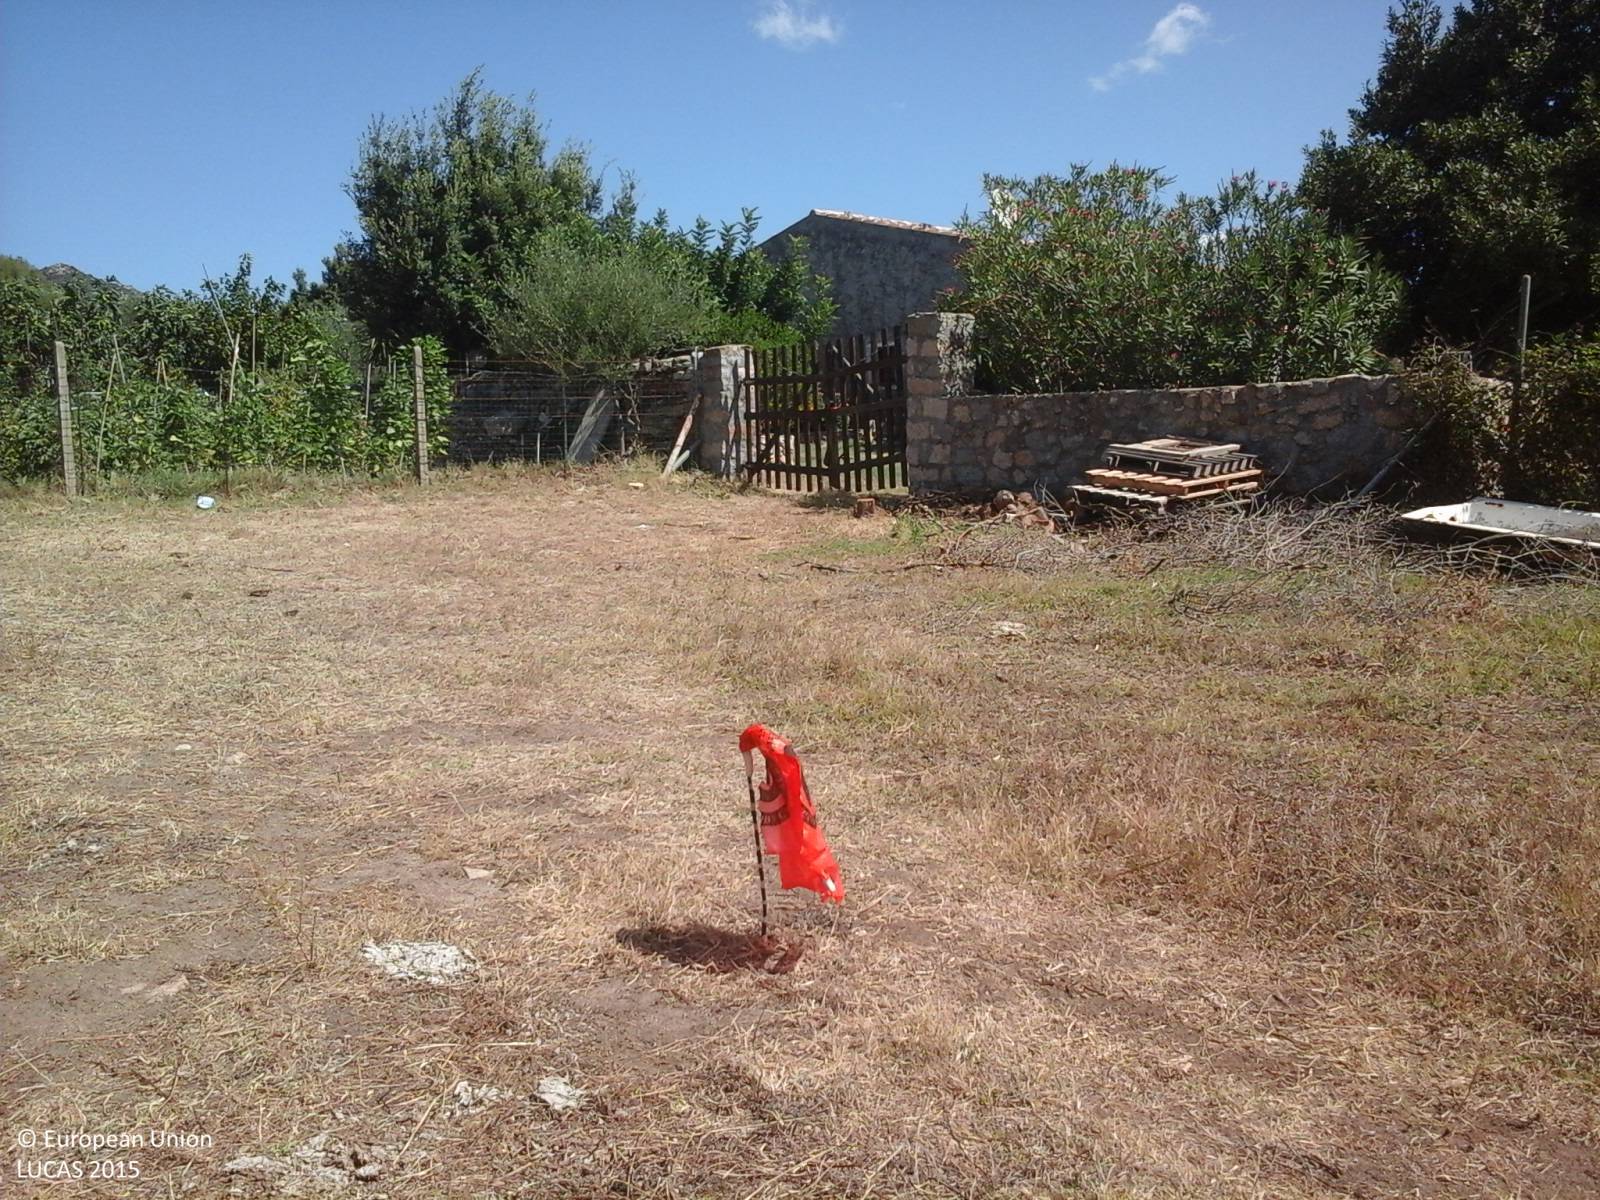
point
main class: Grassland
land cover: Grassland without tree/shrub cover
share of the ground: > 75 %
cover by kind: herbaceous plants 95 %, unconsolidated bare surface 5 %
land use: Agriculture (excluding fallow land and kitchen gardens)
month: August
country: IT
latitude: 41.0079
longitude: 9.4911
